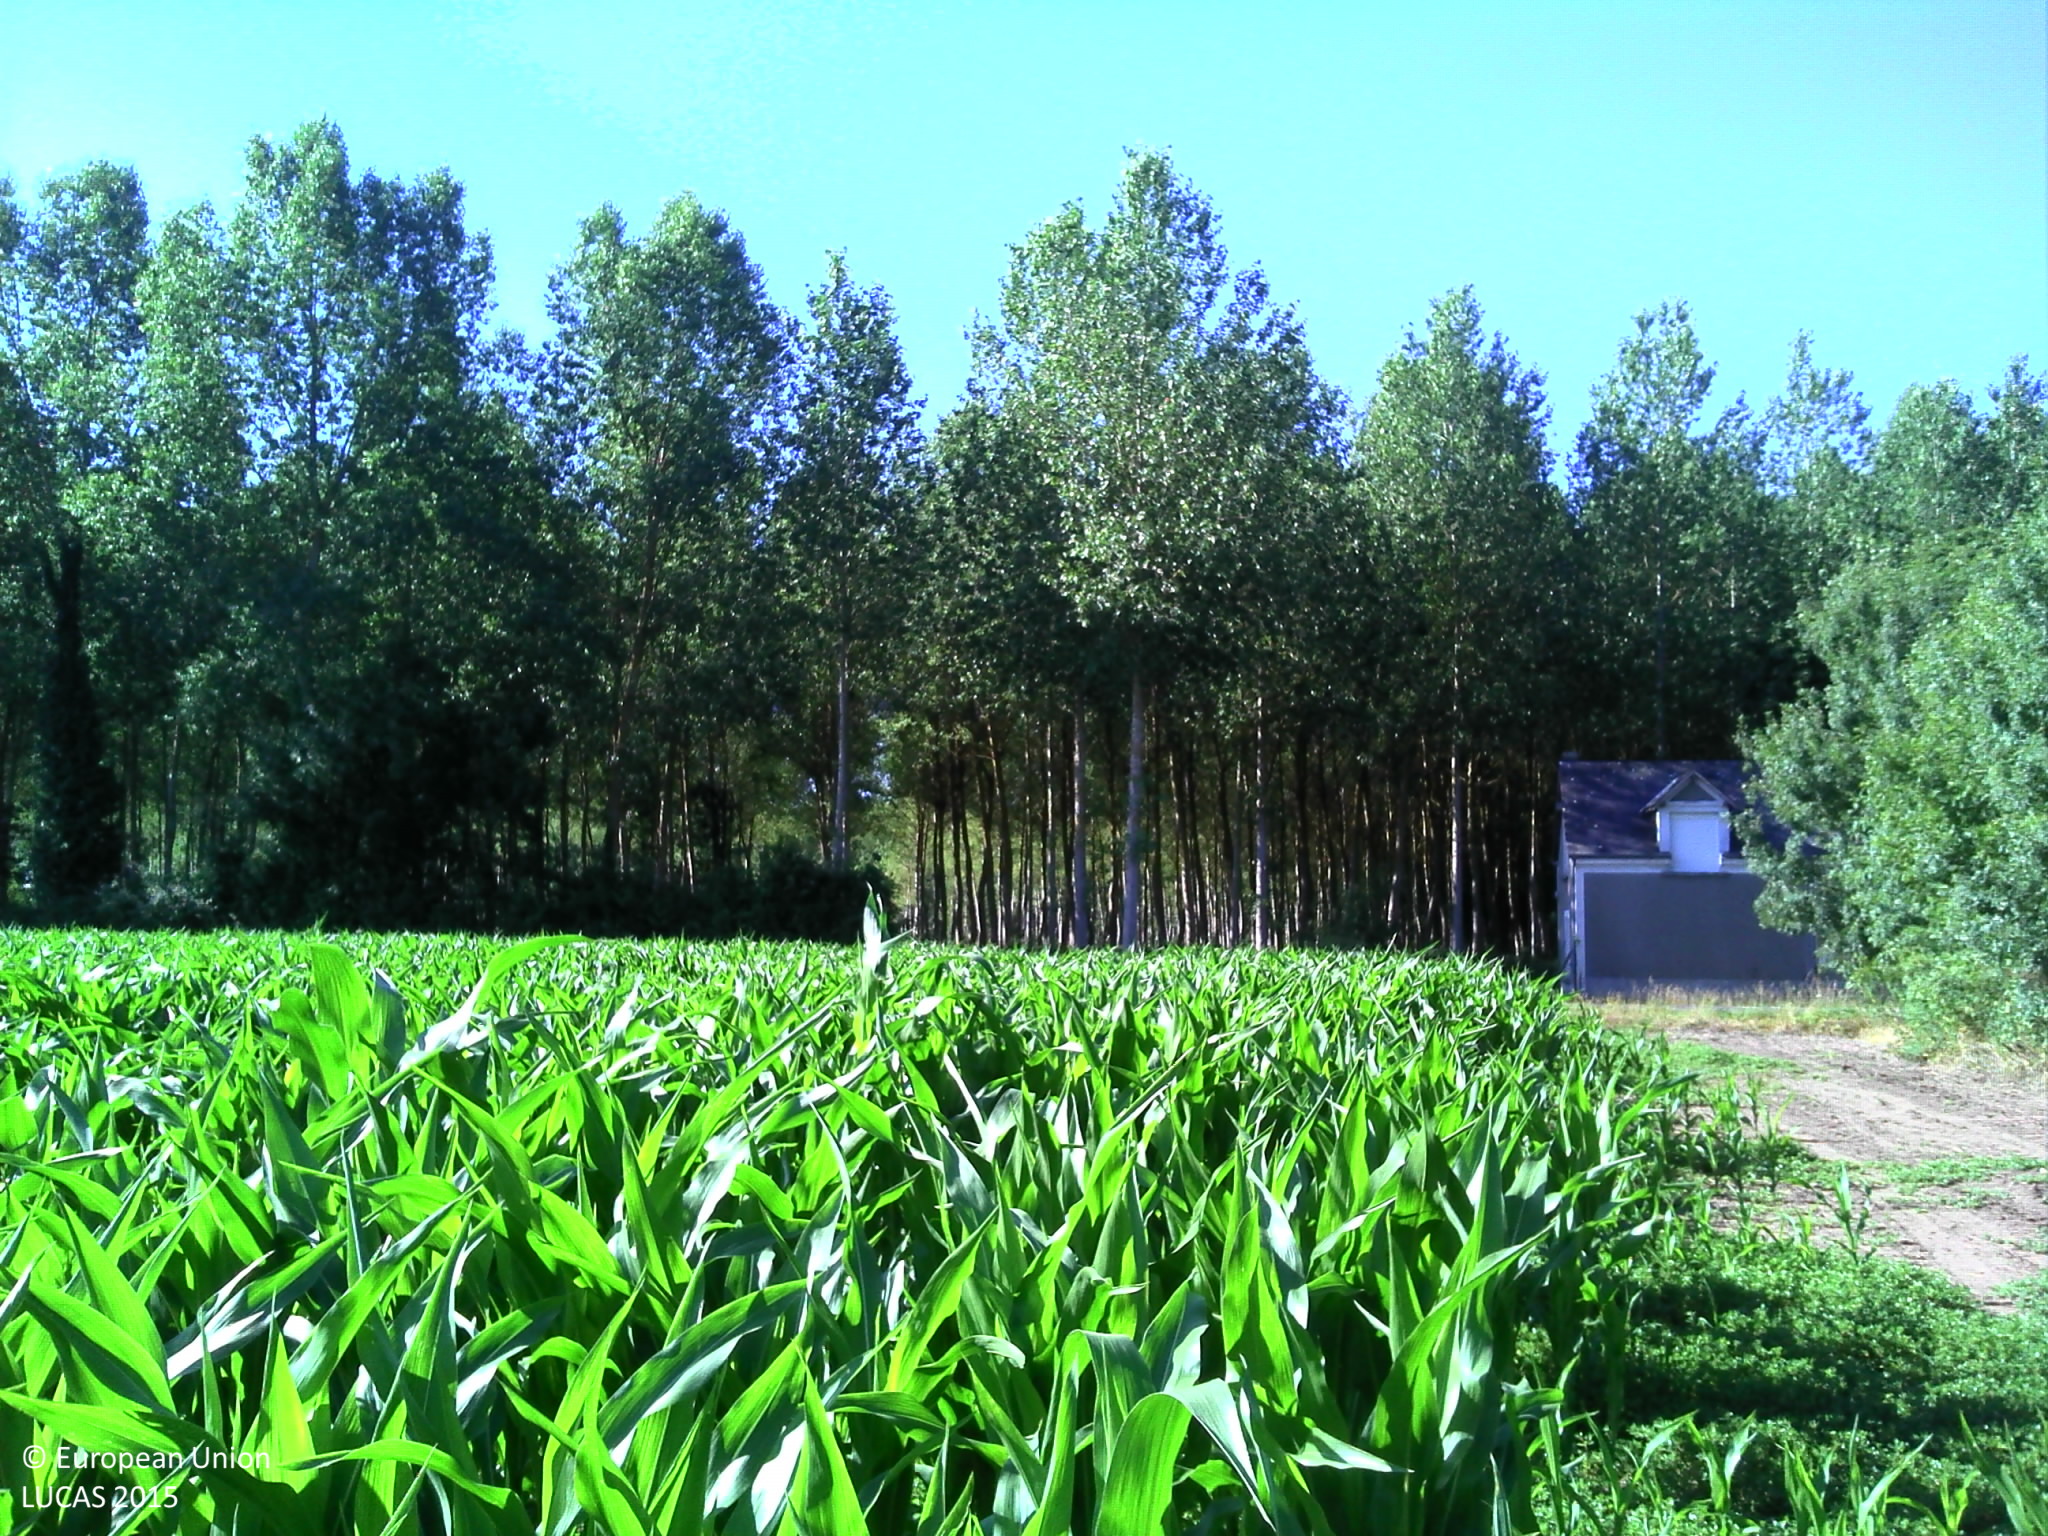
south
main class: Cropland
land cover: Maize
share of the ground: > 75 %
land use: Agriculture (excluding fallow land and kitchen gardens)
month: July
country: FR
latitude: 47.6628
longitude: 0.2414
